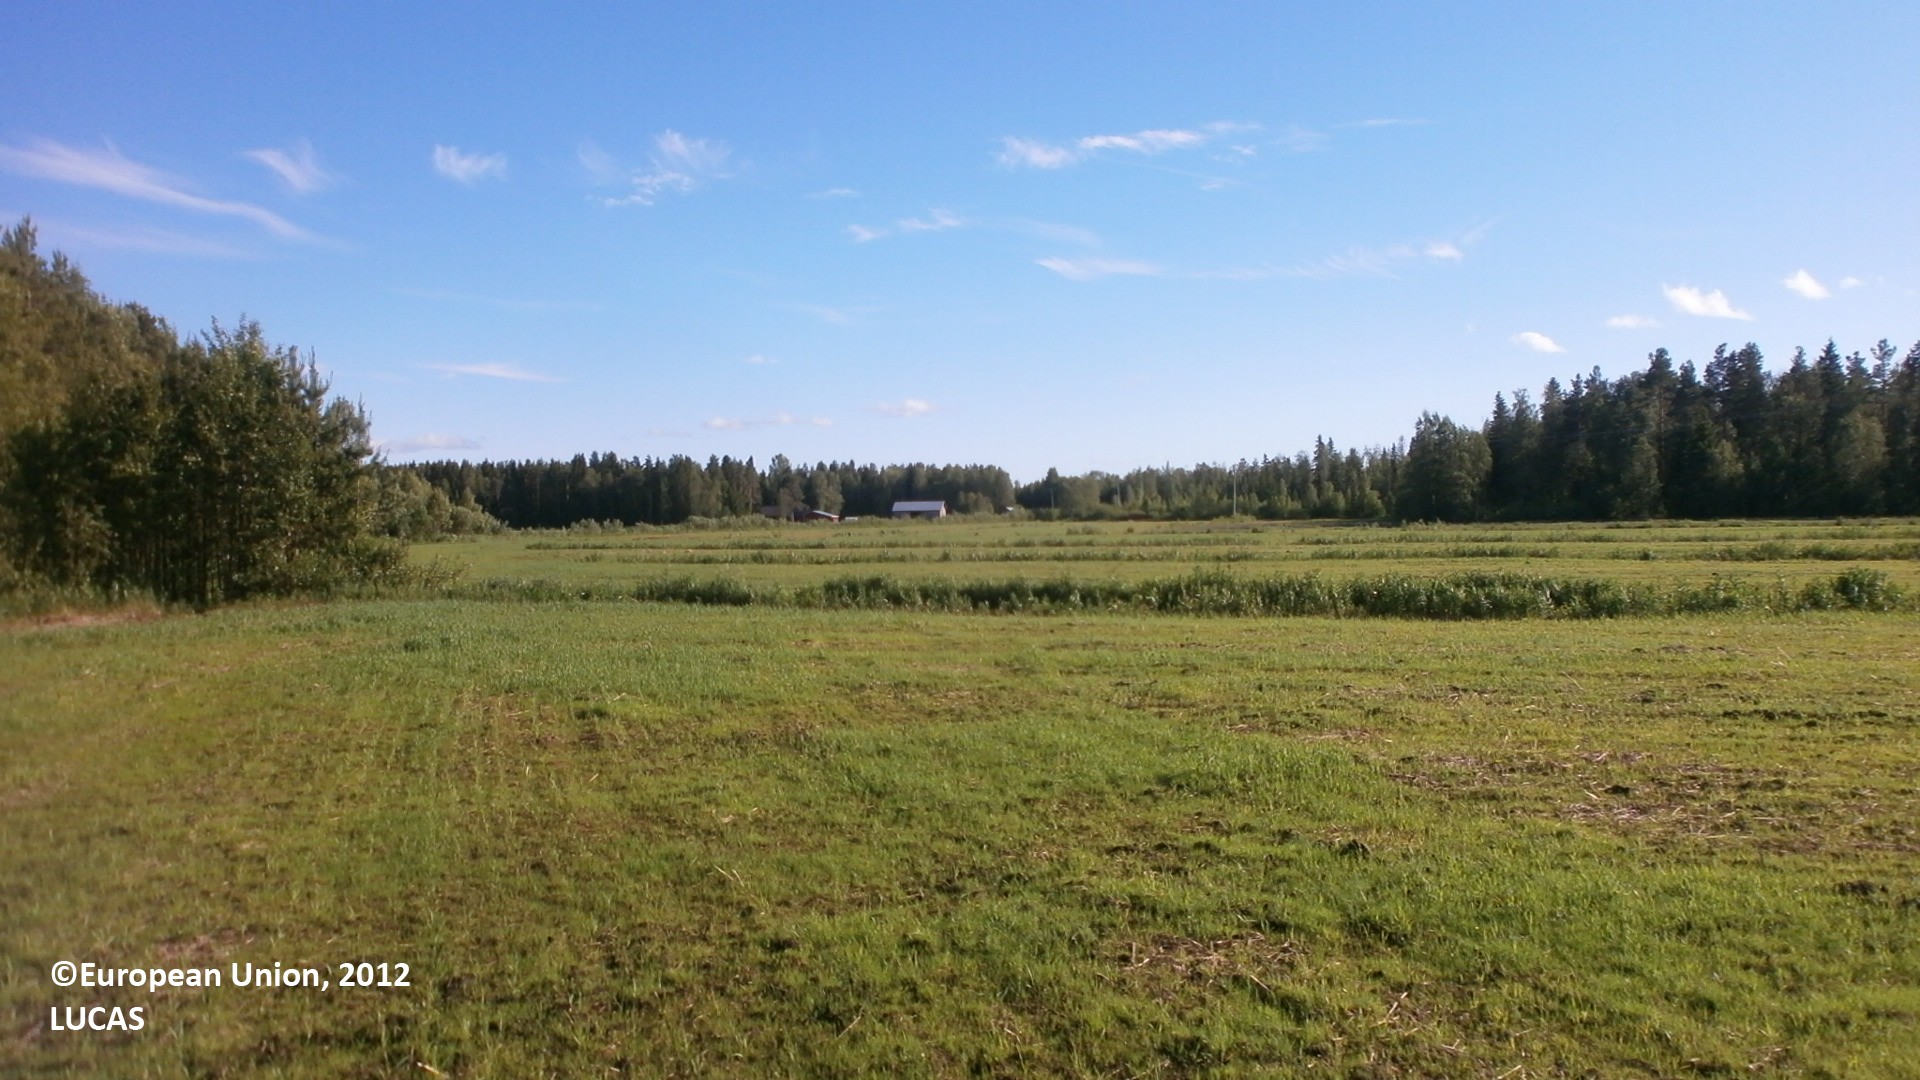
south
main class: Cropland
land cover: Temporary grasslands
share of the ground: 25 - 50 %
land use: Agriculture (excluding fallow land and kitchen gardens)
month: June
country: FI
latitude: 64.4350
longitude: 25.0132
